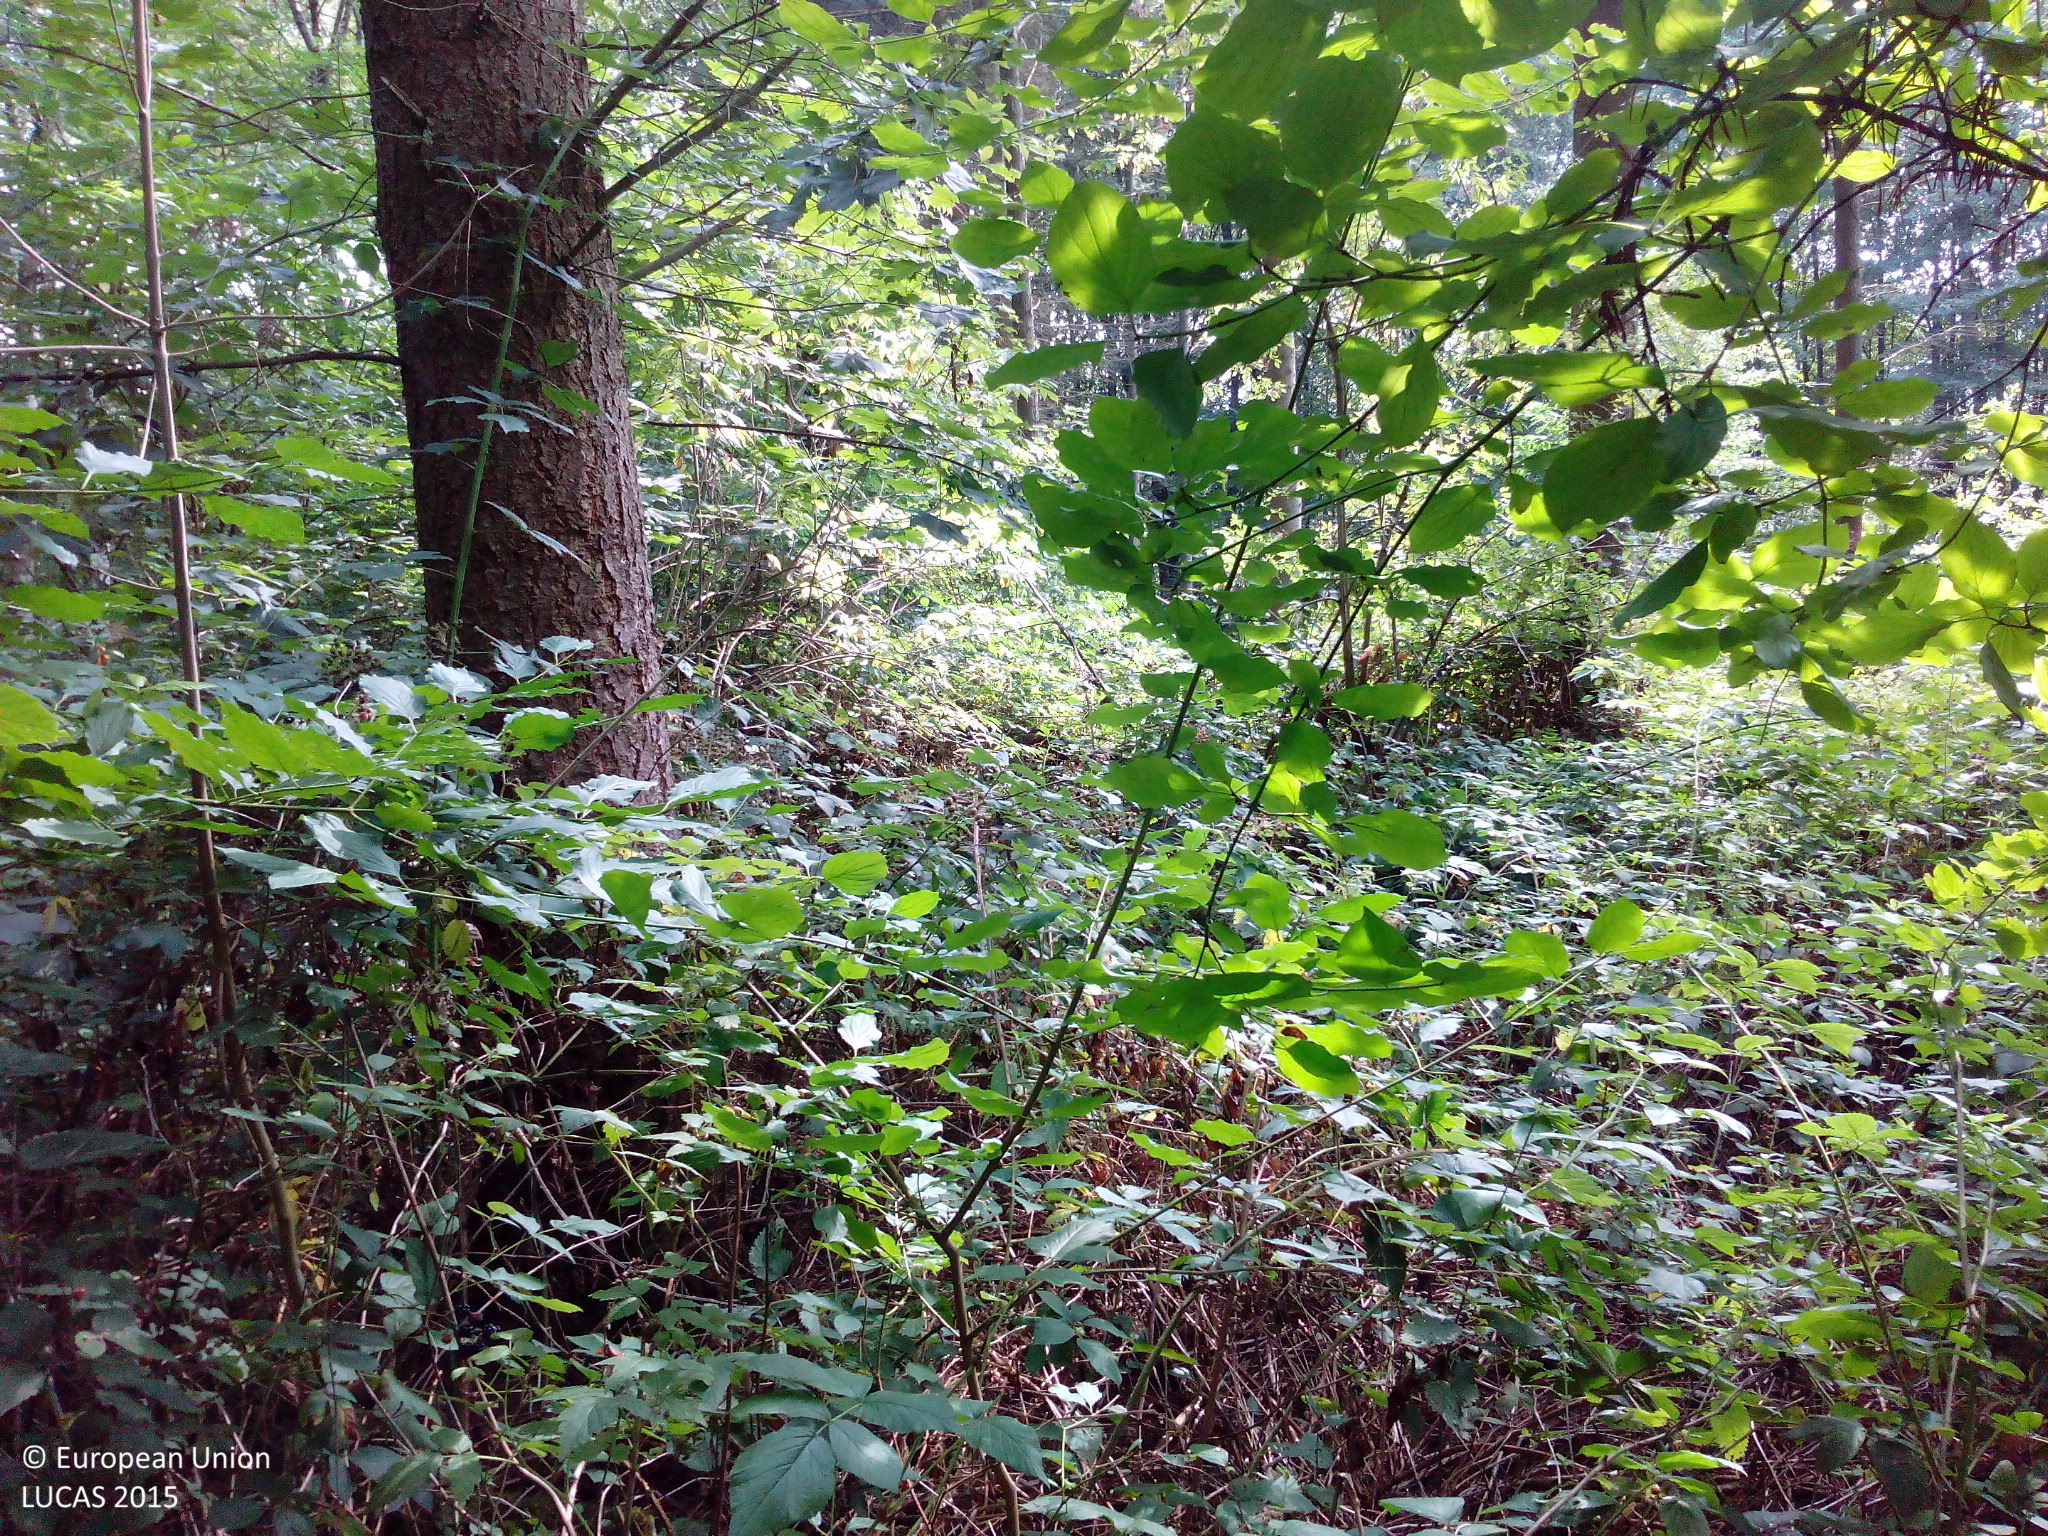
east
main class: Woodland
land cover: Spruce dominated coniferous woodland
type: hemiboreal forest and nemoral coniferous forest and mixed broadleaved-coniferous forest
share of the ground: 50 - 75 %
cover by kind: coniferous forest trees 65 %, shrubs 20 %, broadleaved forest trees 10 %, unconsolidated bare surface 5 %
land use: Forestry
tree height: > 5 m
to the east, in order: Spruce dominated coniferous woodland; Broadleaved woodland; Tracks; Broadleaved woodland; Other bare soil
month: August
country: DE
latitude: 50.3358
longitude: 7.4573
